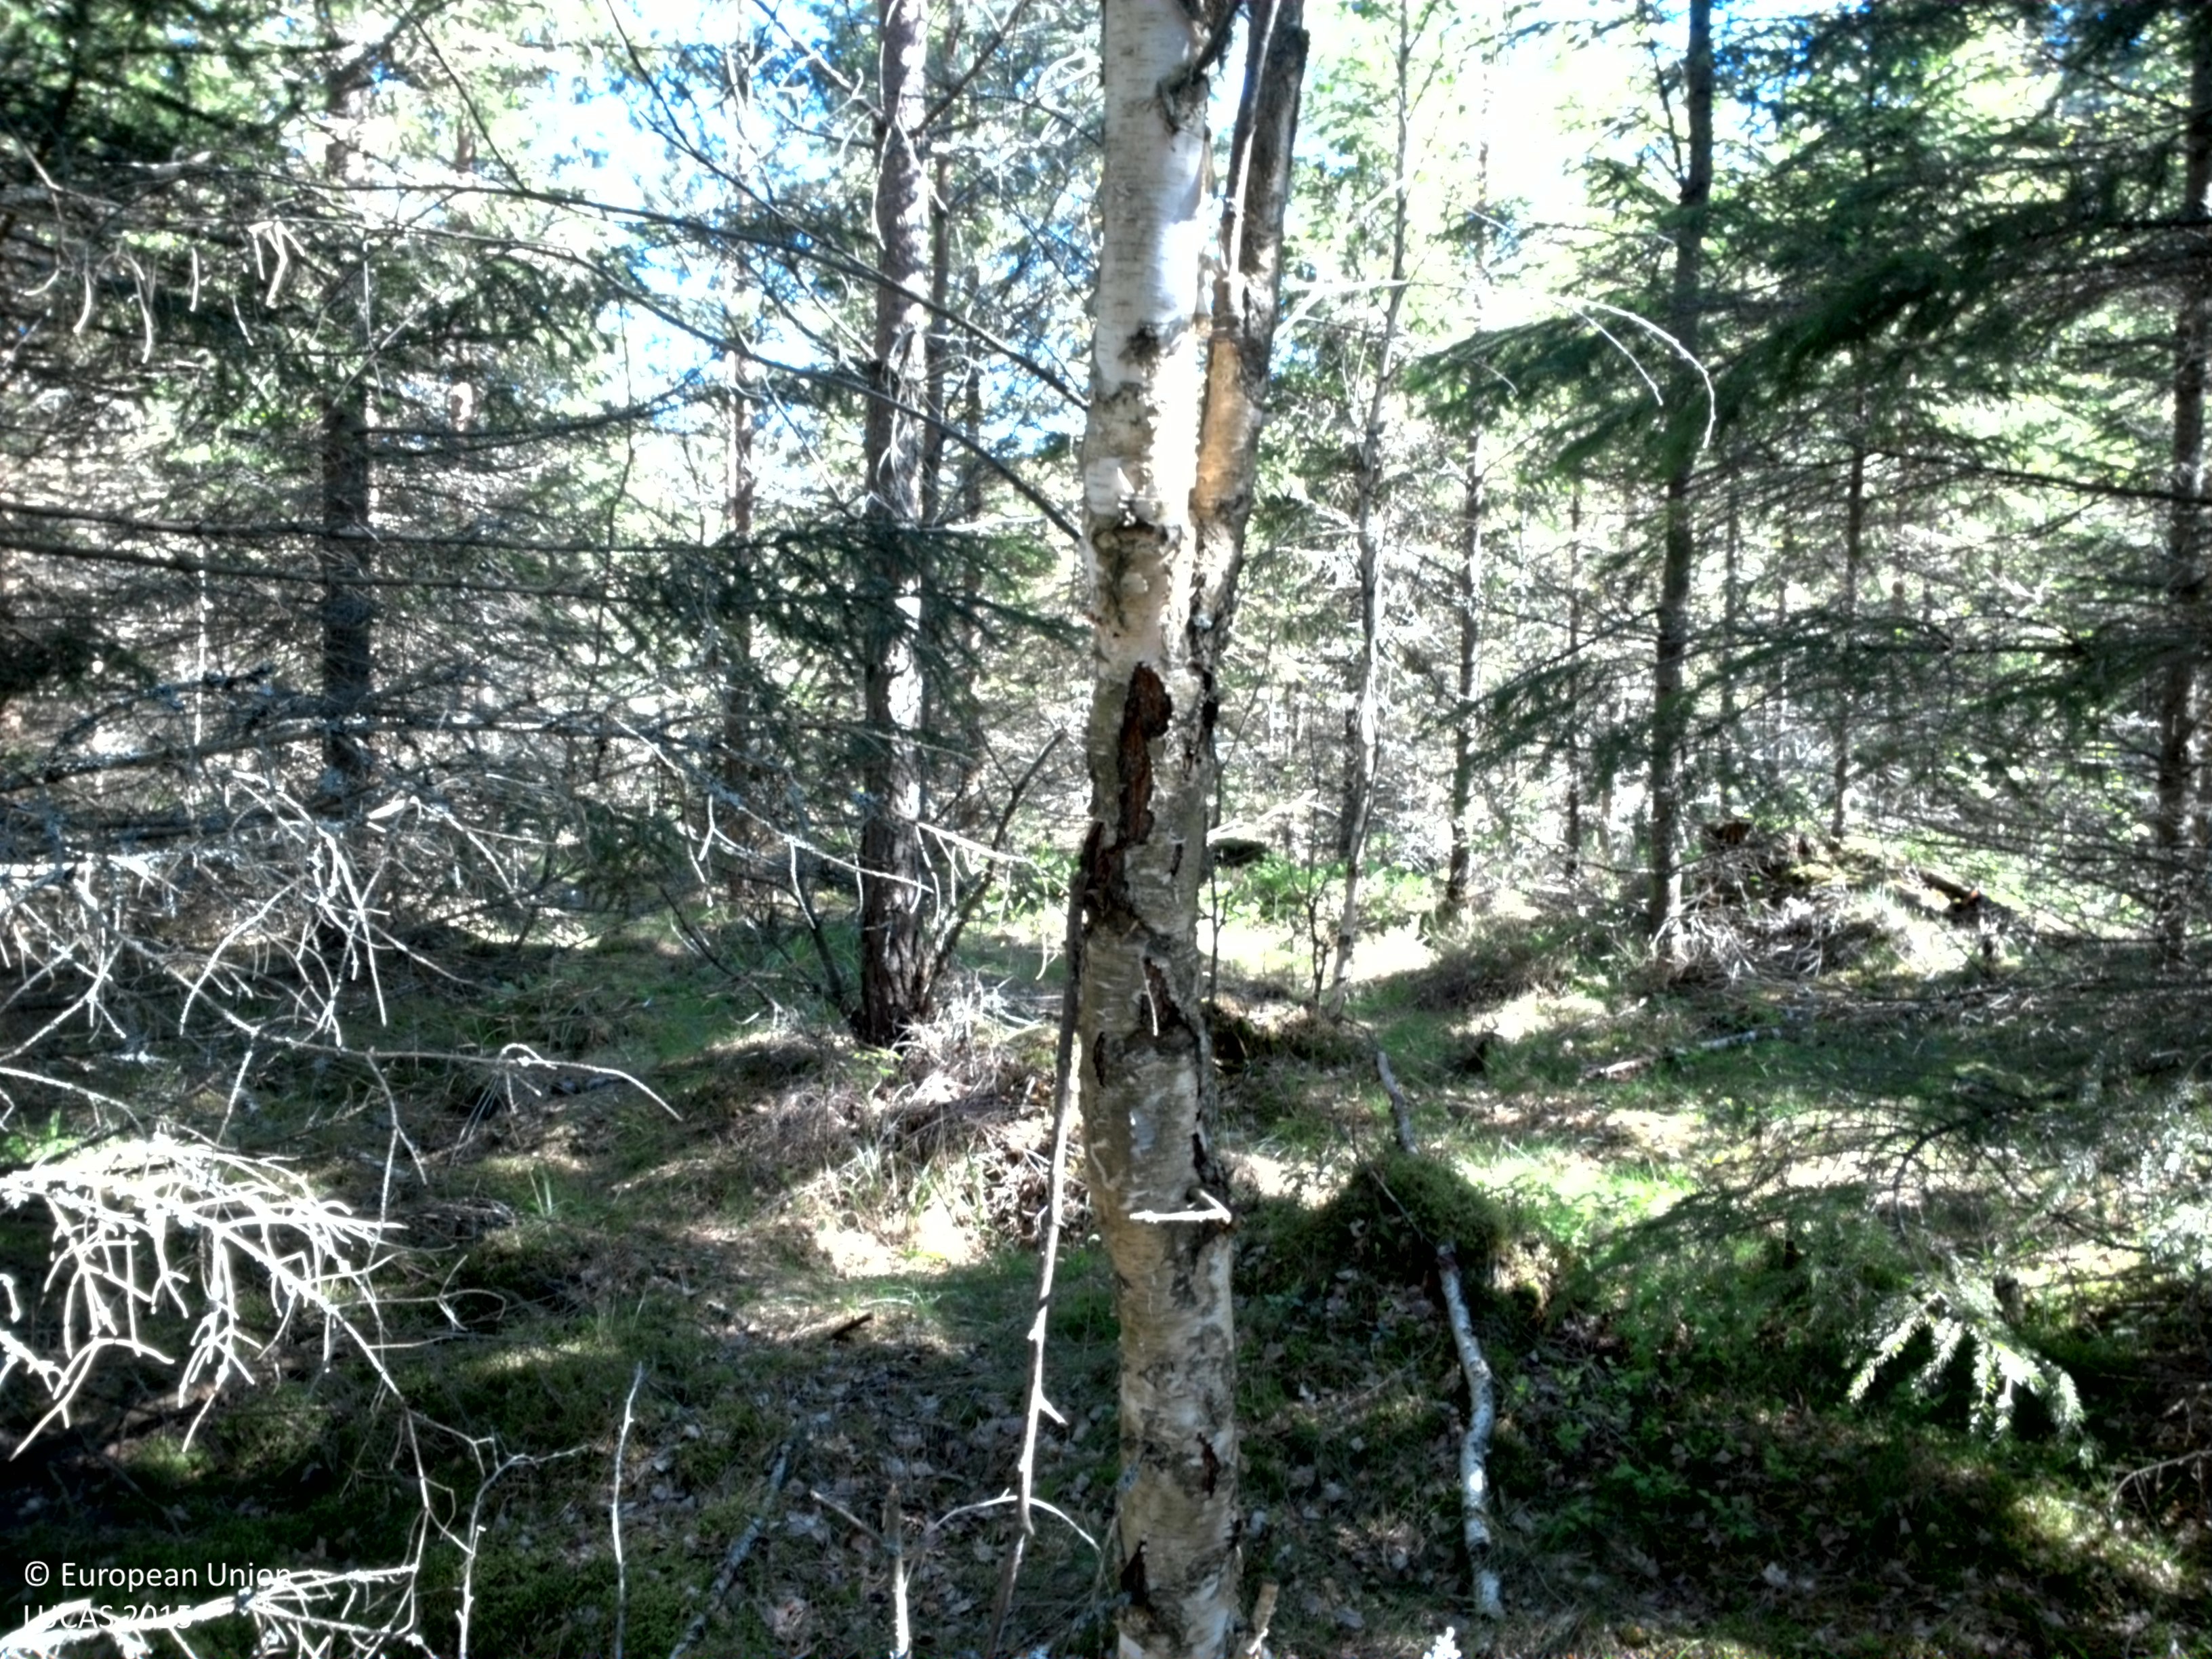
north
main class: Woodland
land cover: Spruce dominated mixed woodland
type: boreal forest
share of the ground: > 75 %
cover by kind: coniferous forest trees 70 %, broadleaved forest trees 25 %, lichens and mosses 5 %
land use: Forestry
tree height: > 5 m
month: June
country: SE
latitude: 58.7018
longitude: 14.5320
